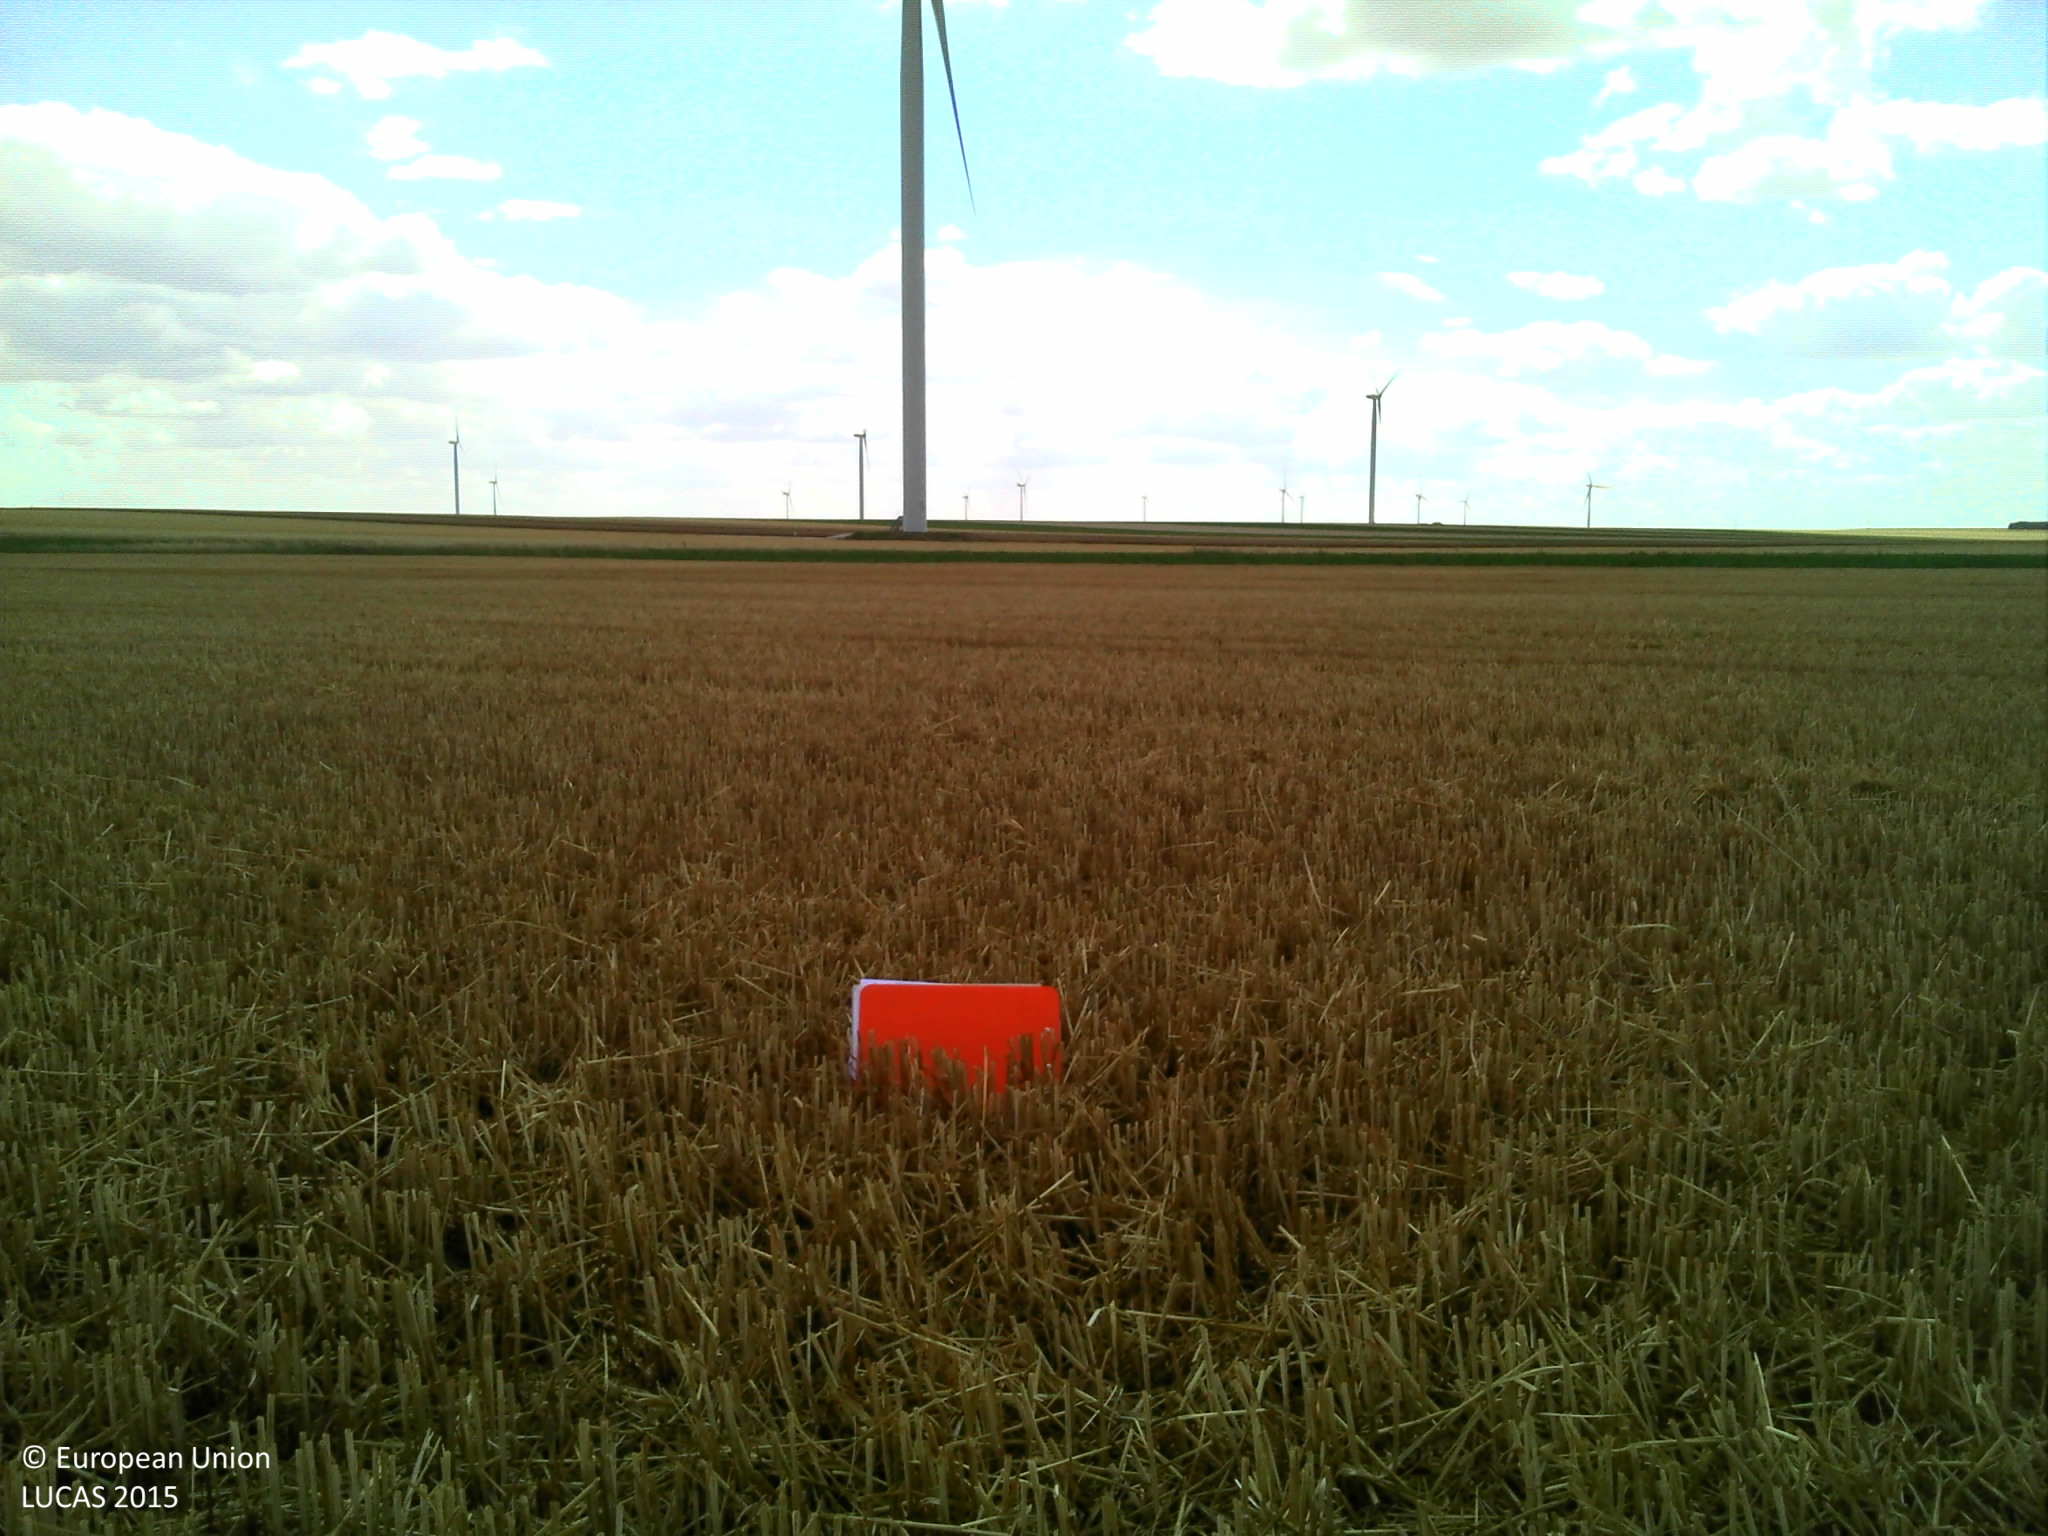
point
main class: Cropland
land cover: Common wheat
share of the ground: > 75 %
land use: Agriculture (excluding fallow land and kitchen gardens)
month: July
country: FR
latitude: 48.8783
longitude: 4.1187
